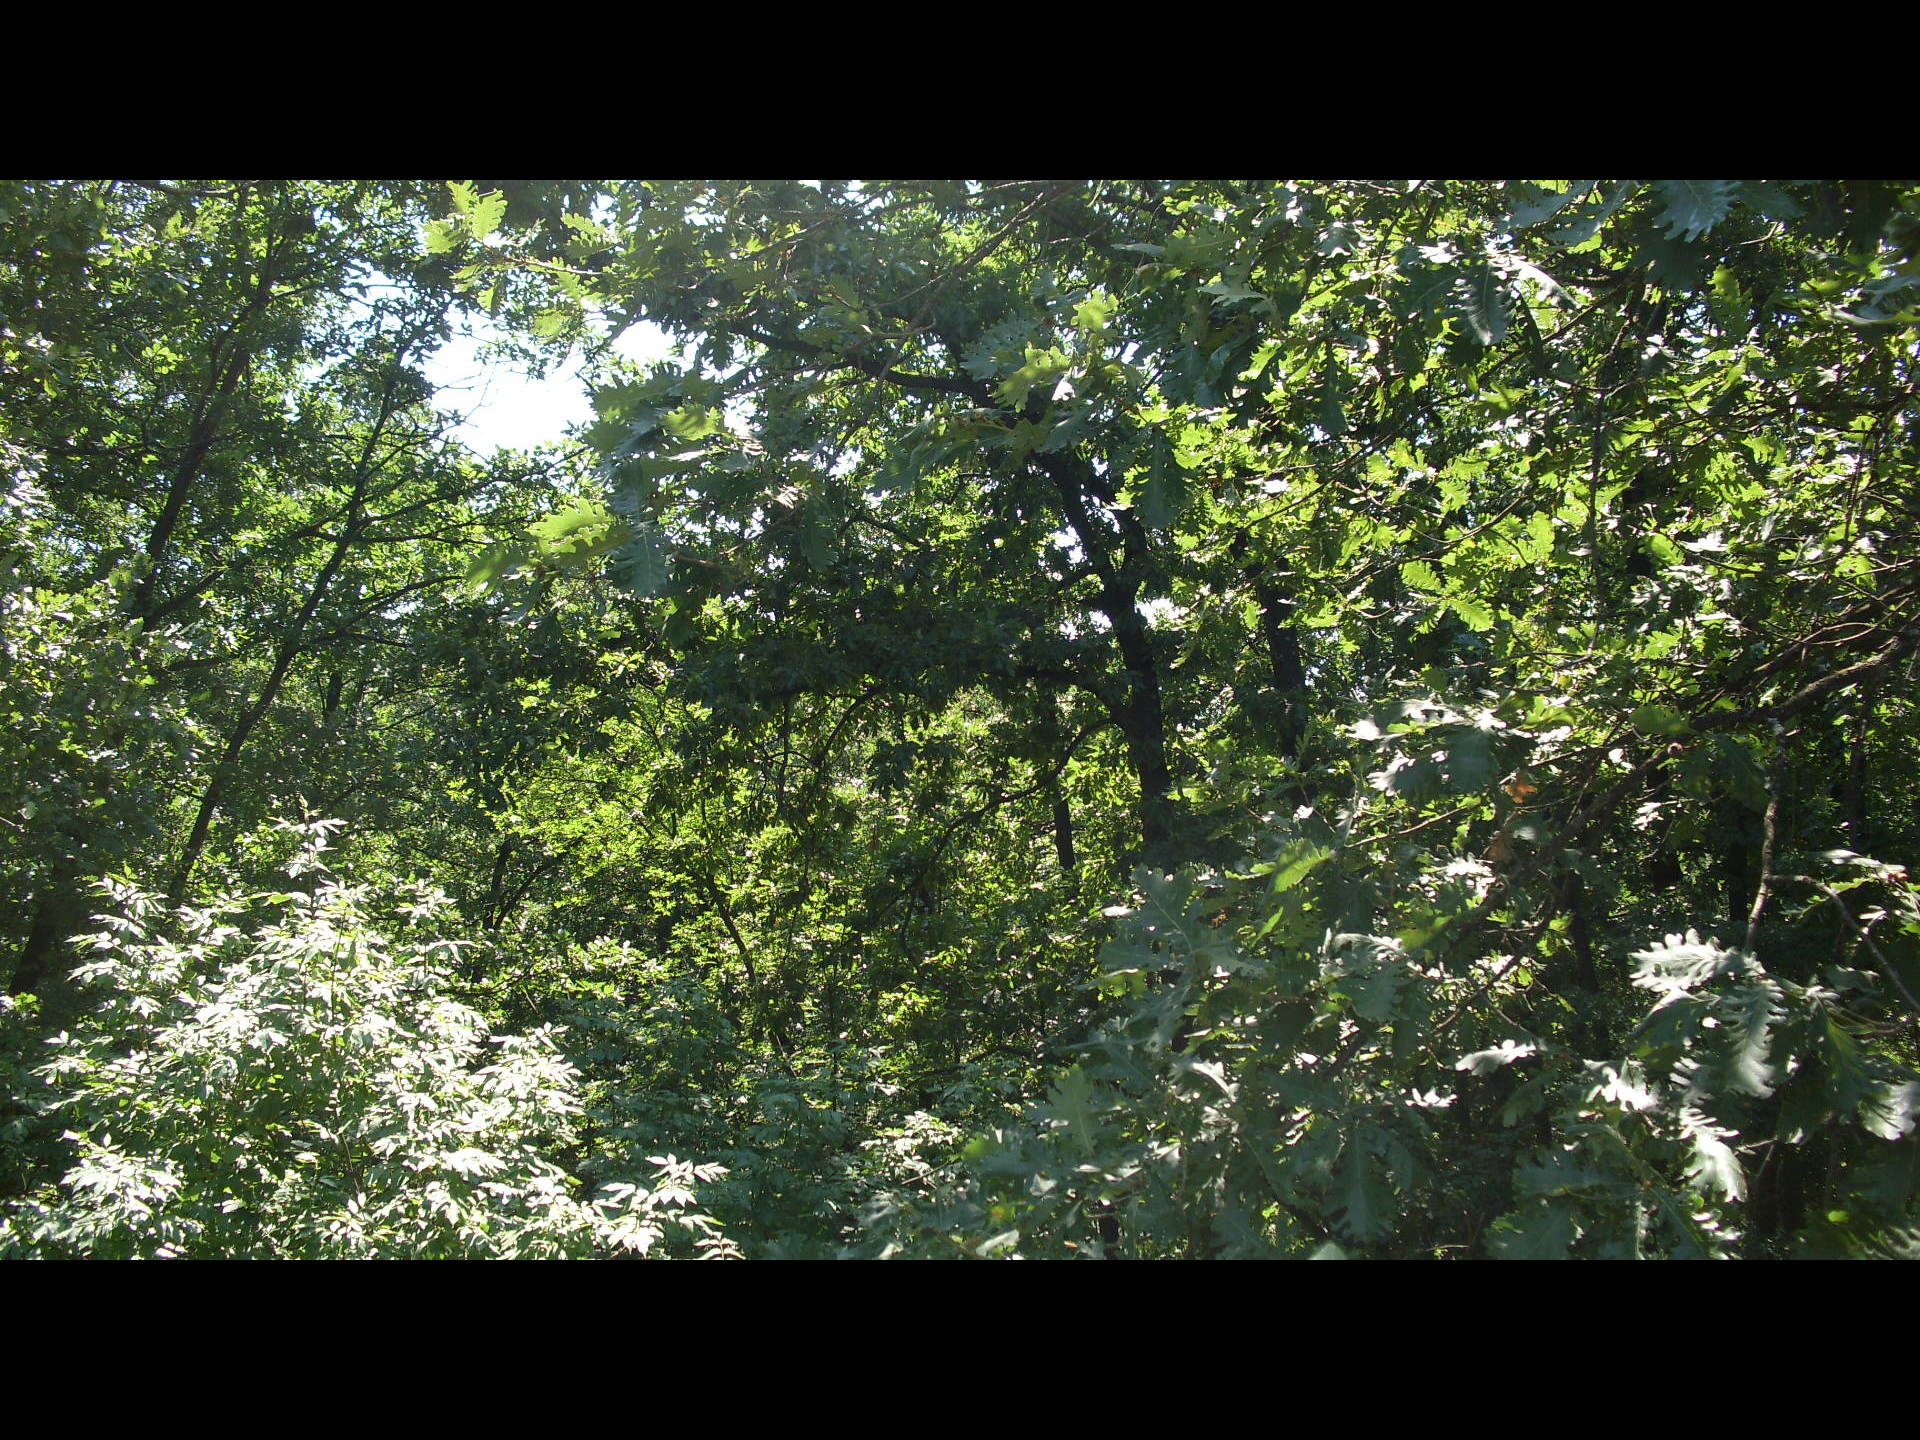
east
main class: Woodland
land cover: Broadleaved woodland
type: mesophytic deciduous forest
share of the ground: > 75 %
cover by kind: broadleaved forest trees 75 %, herbaceous plants 15 %, shrubs 10 %
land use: Forestry
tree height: > 5 m
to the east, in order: Broadleaved woodland; Shrubland with sparse tree cover; Broadleaved woodland; Shrubland with sparse tree cover; Broadleaved woodland
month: July
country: BG
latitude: 43.7357
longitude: 22.6614
